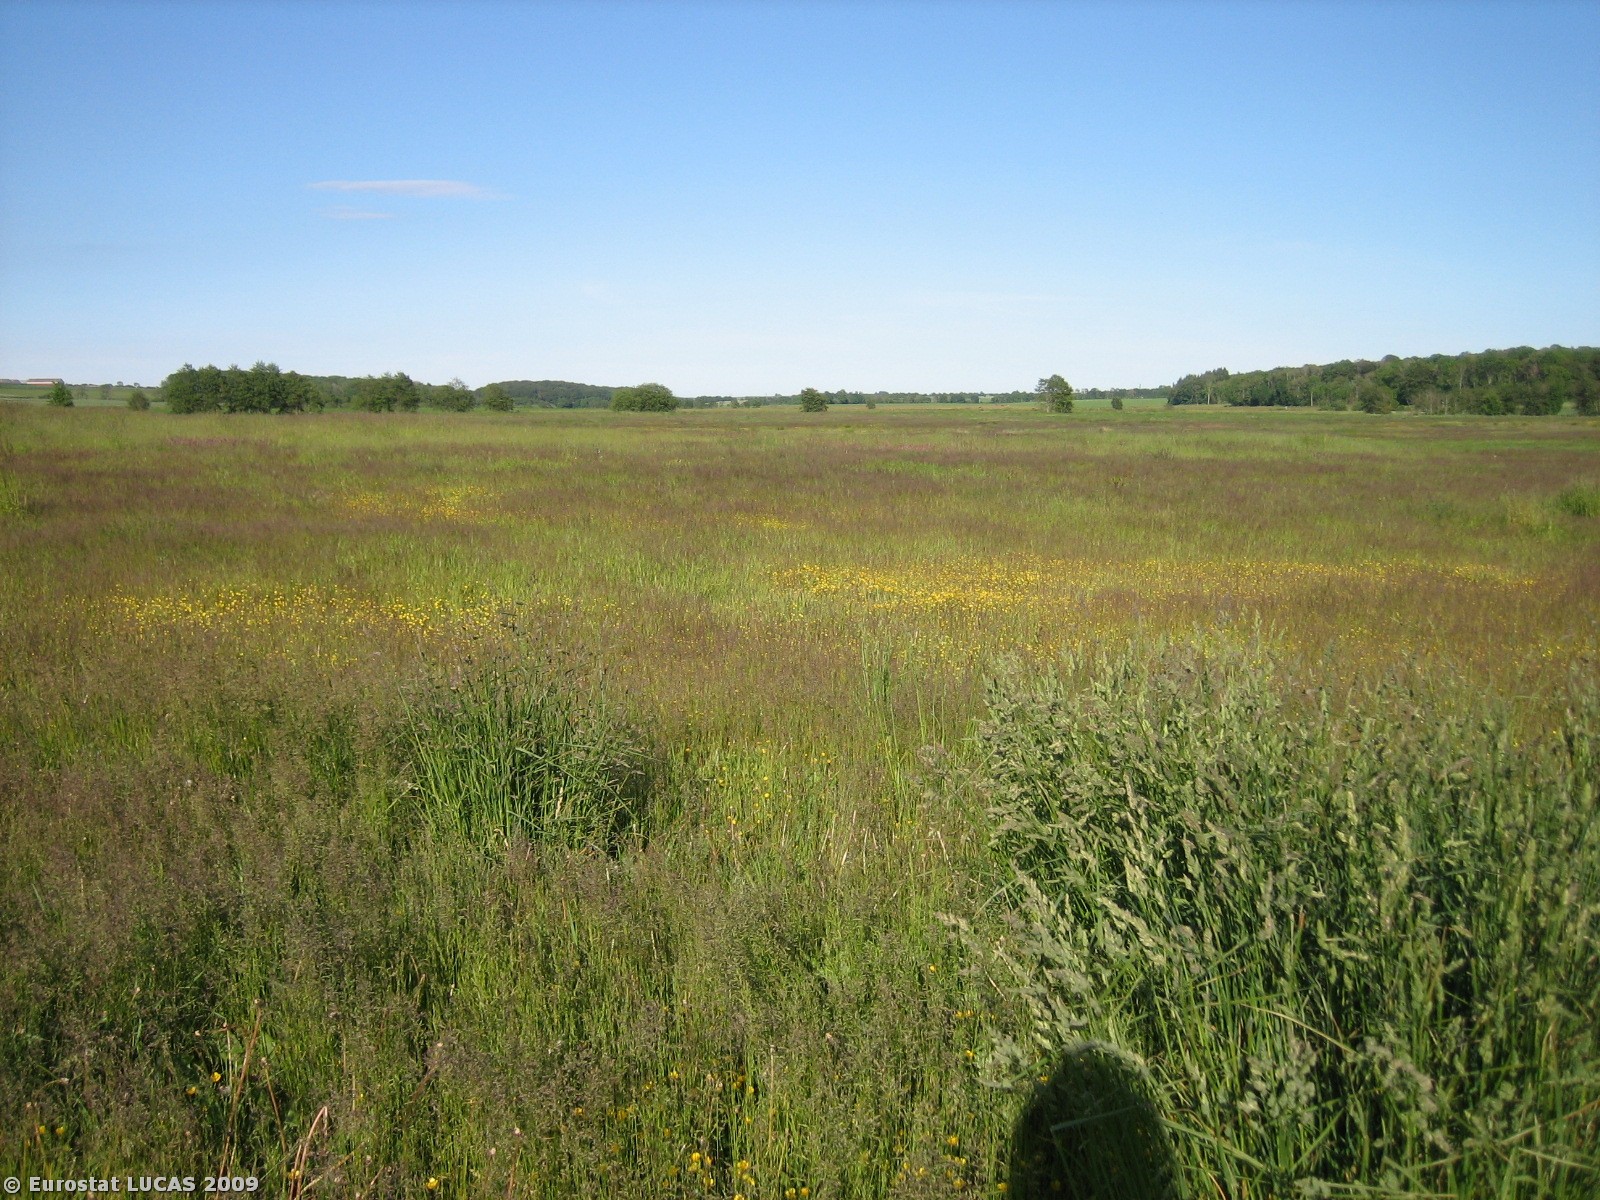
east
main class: Grassland
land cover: Grassland without tree/shrub cover
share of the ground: > 75 %
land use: Unused
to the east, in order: Grassland without tree/shrub cover; Inland marshes; Grassland without tree/shrub cover
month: June
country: DK
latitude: 56.1697
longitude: 9.9196
